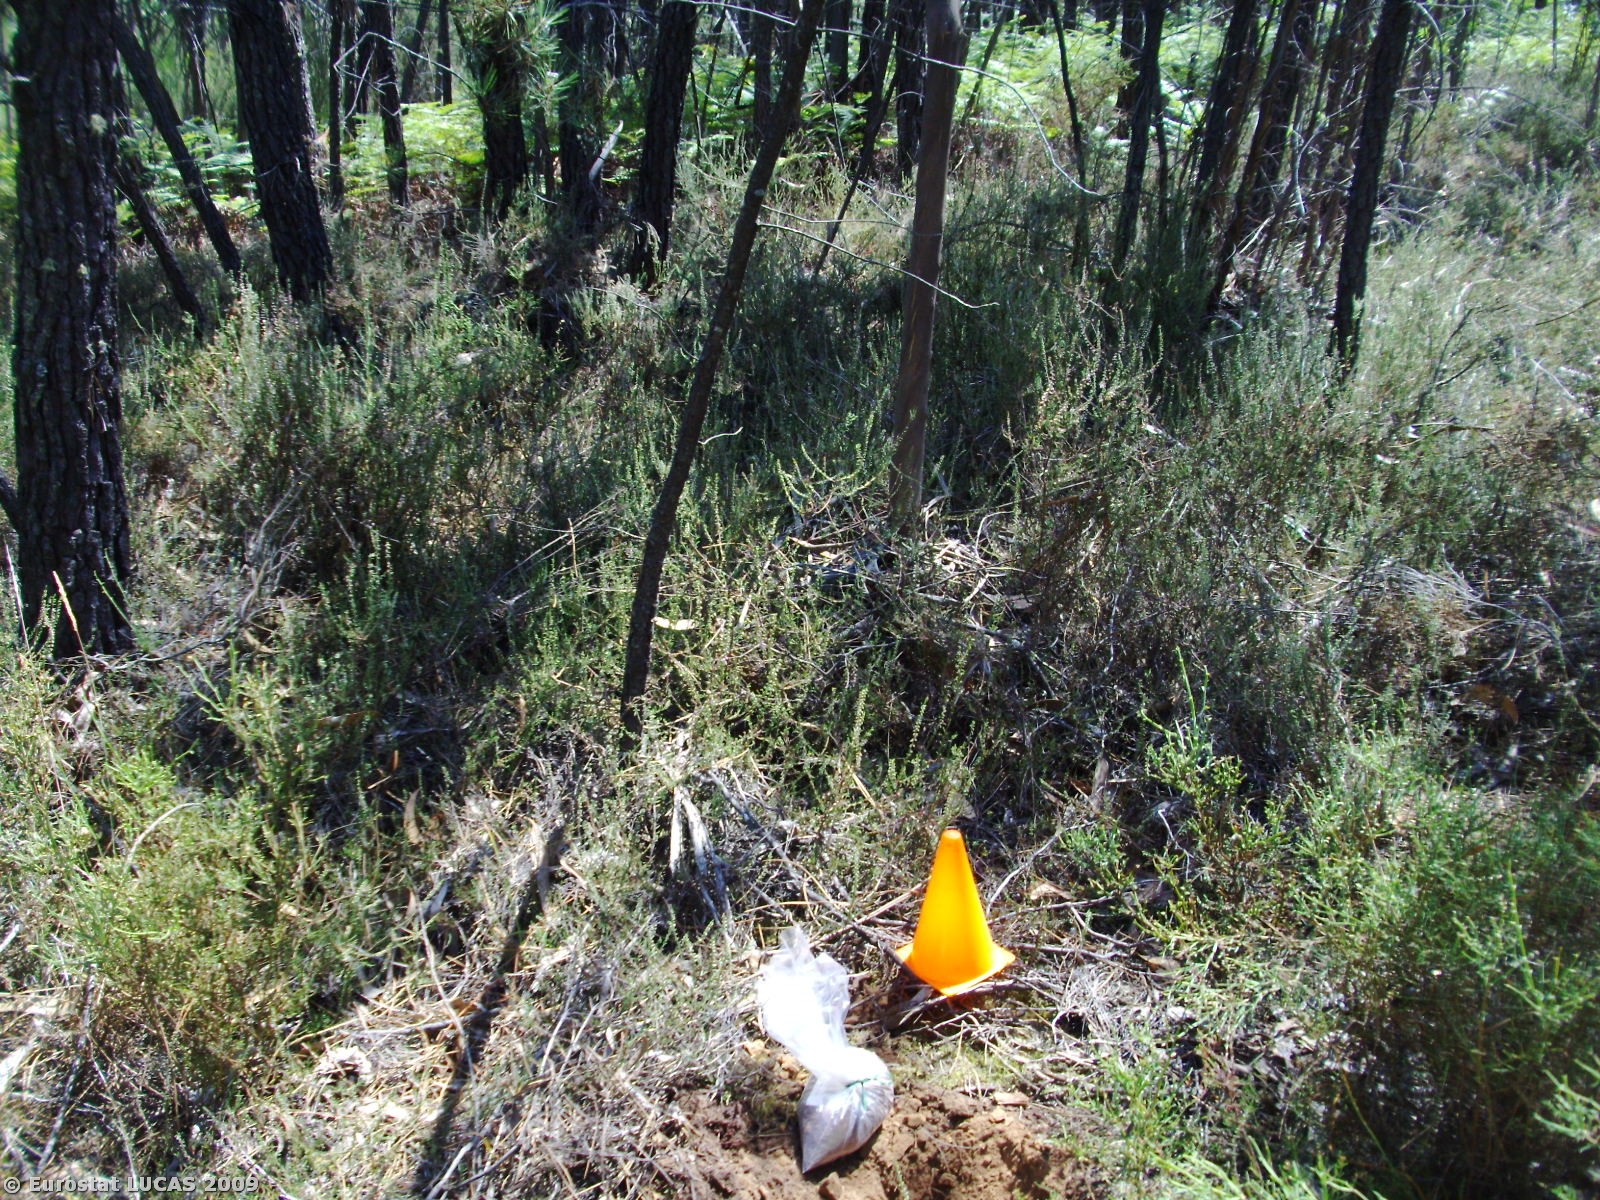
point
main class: Woodland
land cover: Coniferous woodland
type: coniferous forest of the mediterranean region
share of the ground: > 75 %
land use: Forestry
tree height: > 5 m
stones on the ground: > 50 %
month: August
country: PT
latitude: 39.9137
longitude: -8.2169
